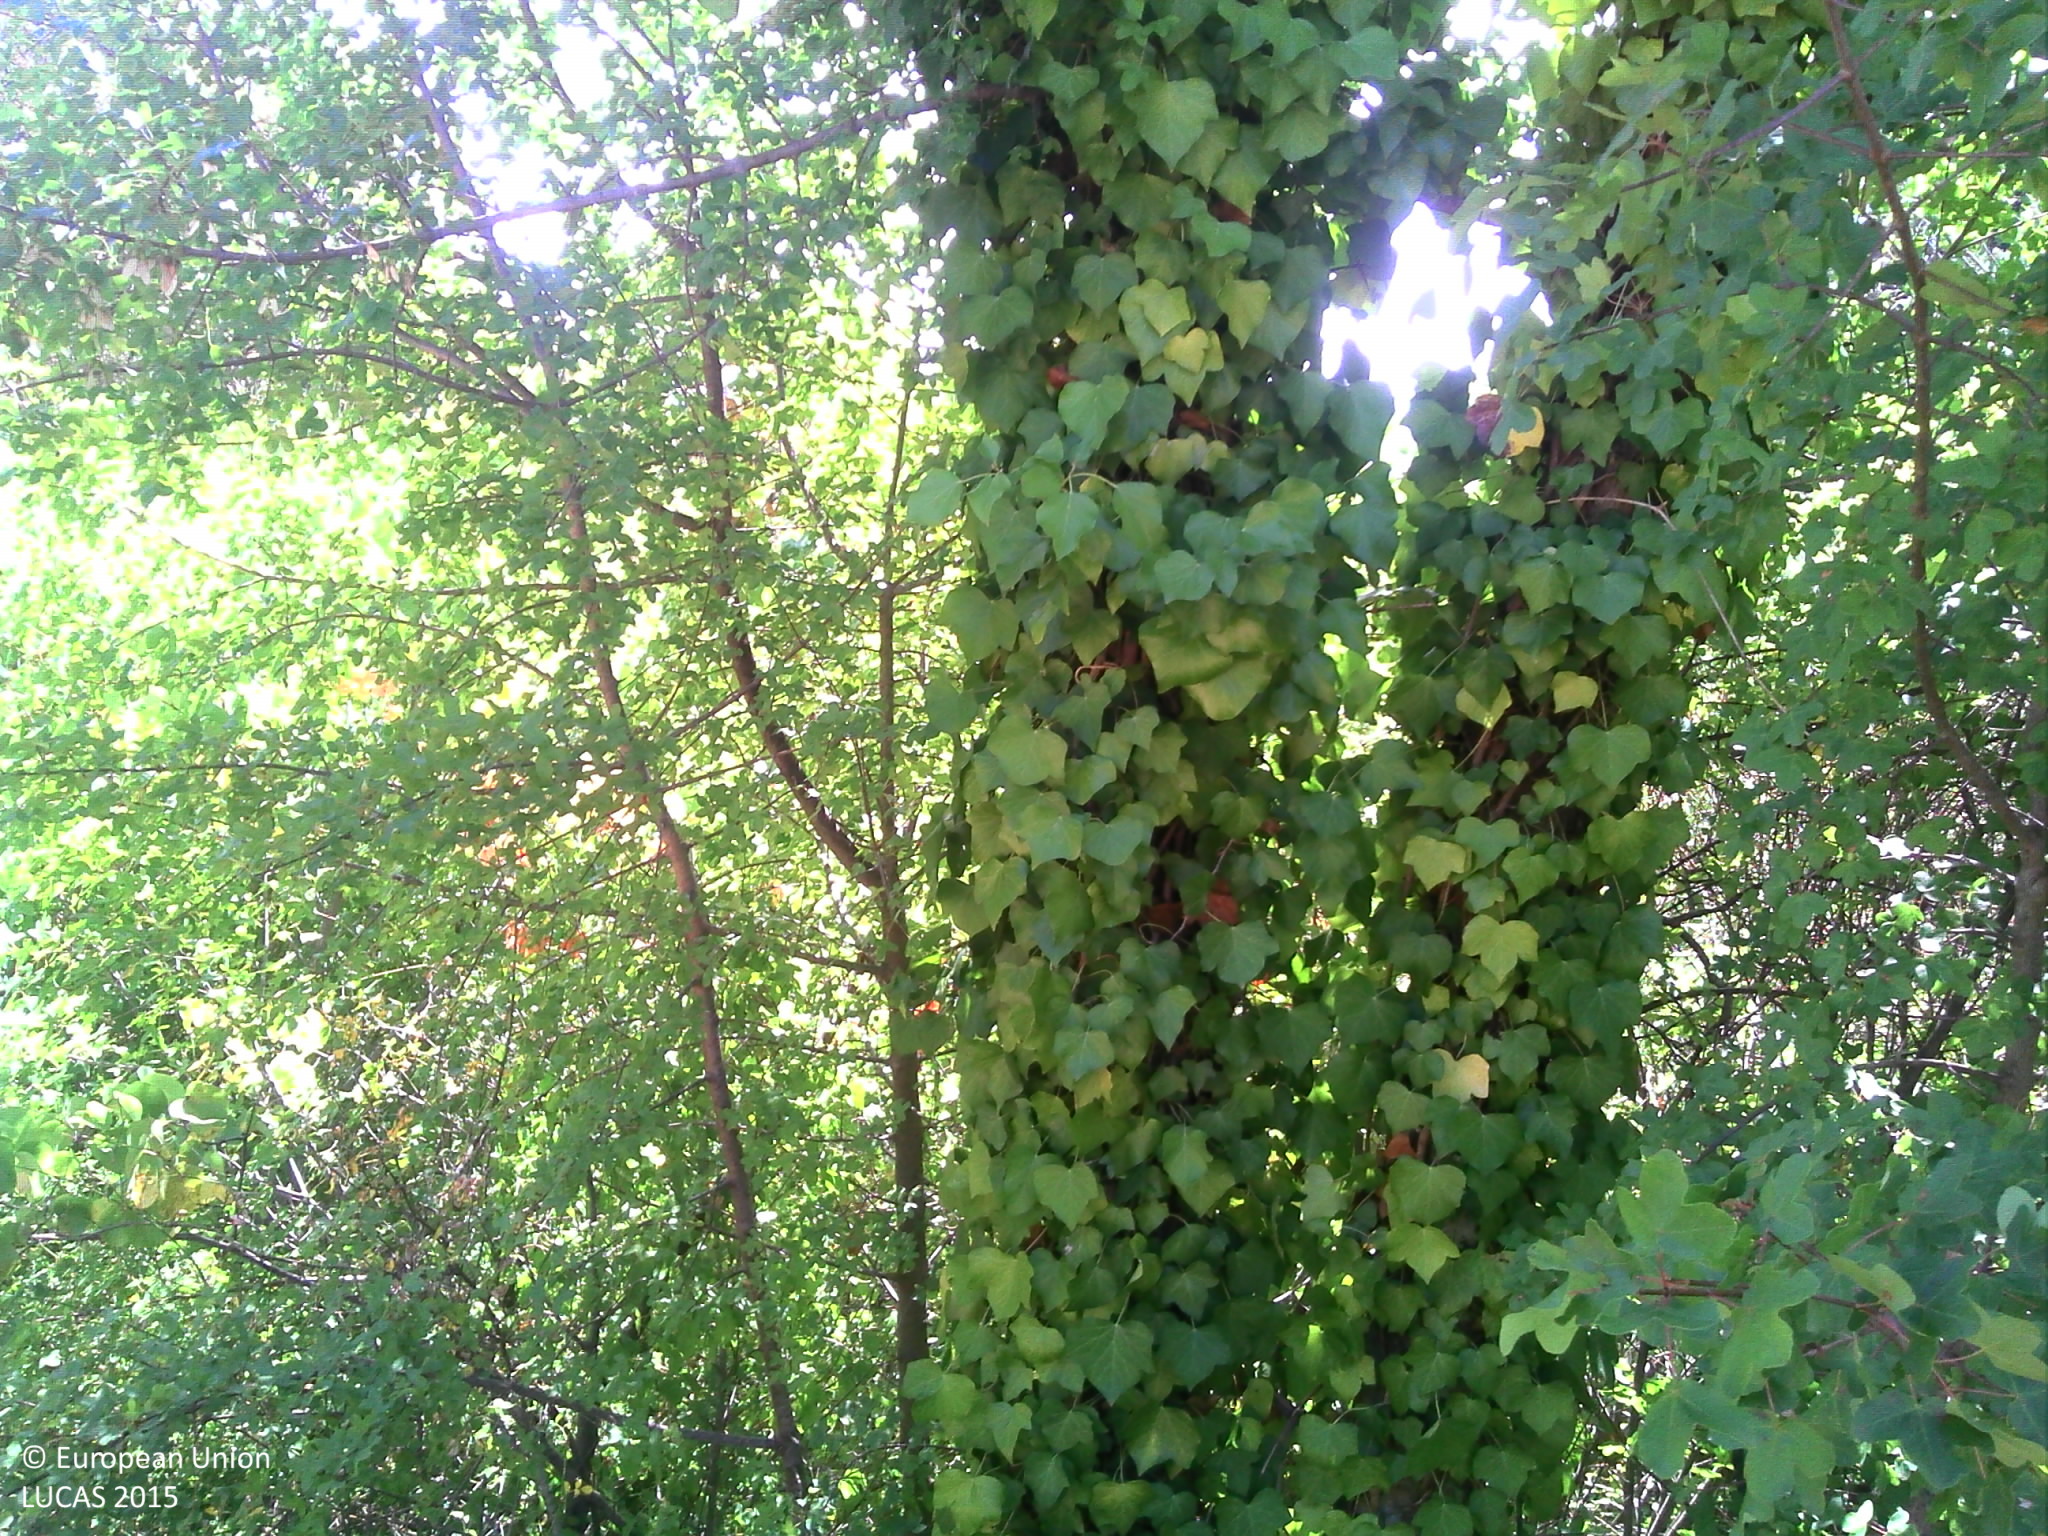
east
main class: Woodland
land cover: Other mixed woodland
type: broadleaved evergreen forest
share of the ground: > 75 %
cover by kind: broadleaved forest trees 50 %, coniferous forest trees 25 %, herbaceous plants 25 %
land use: Semi-natural and natural areas not in use
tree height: > 5 m
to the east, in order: Other mixed woodland; Tracks; Other mixed woodland; Tracks; Other mixed woodland
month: July
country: FR
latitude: 44.5755
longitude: 4.6797
